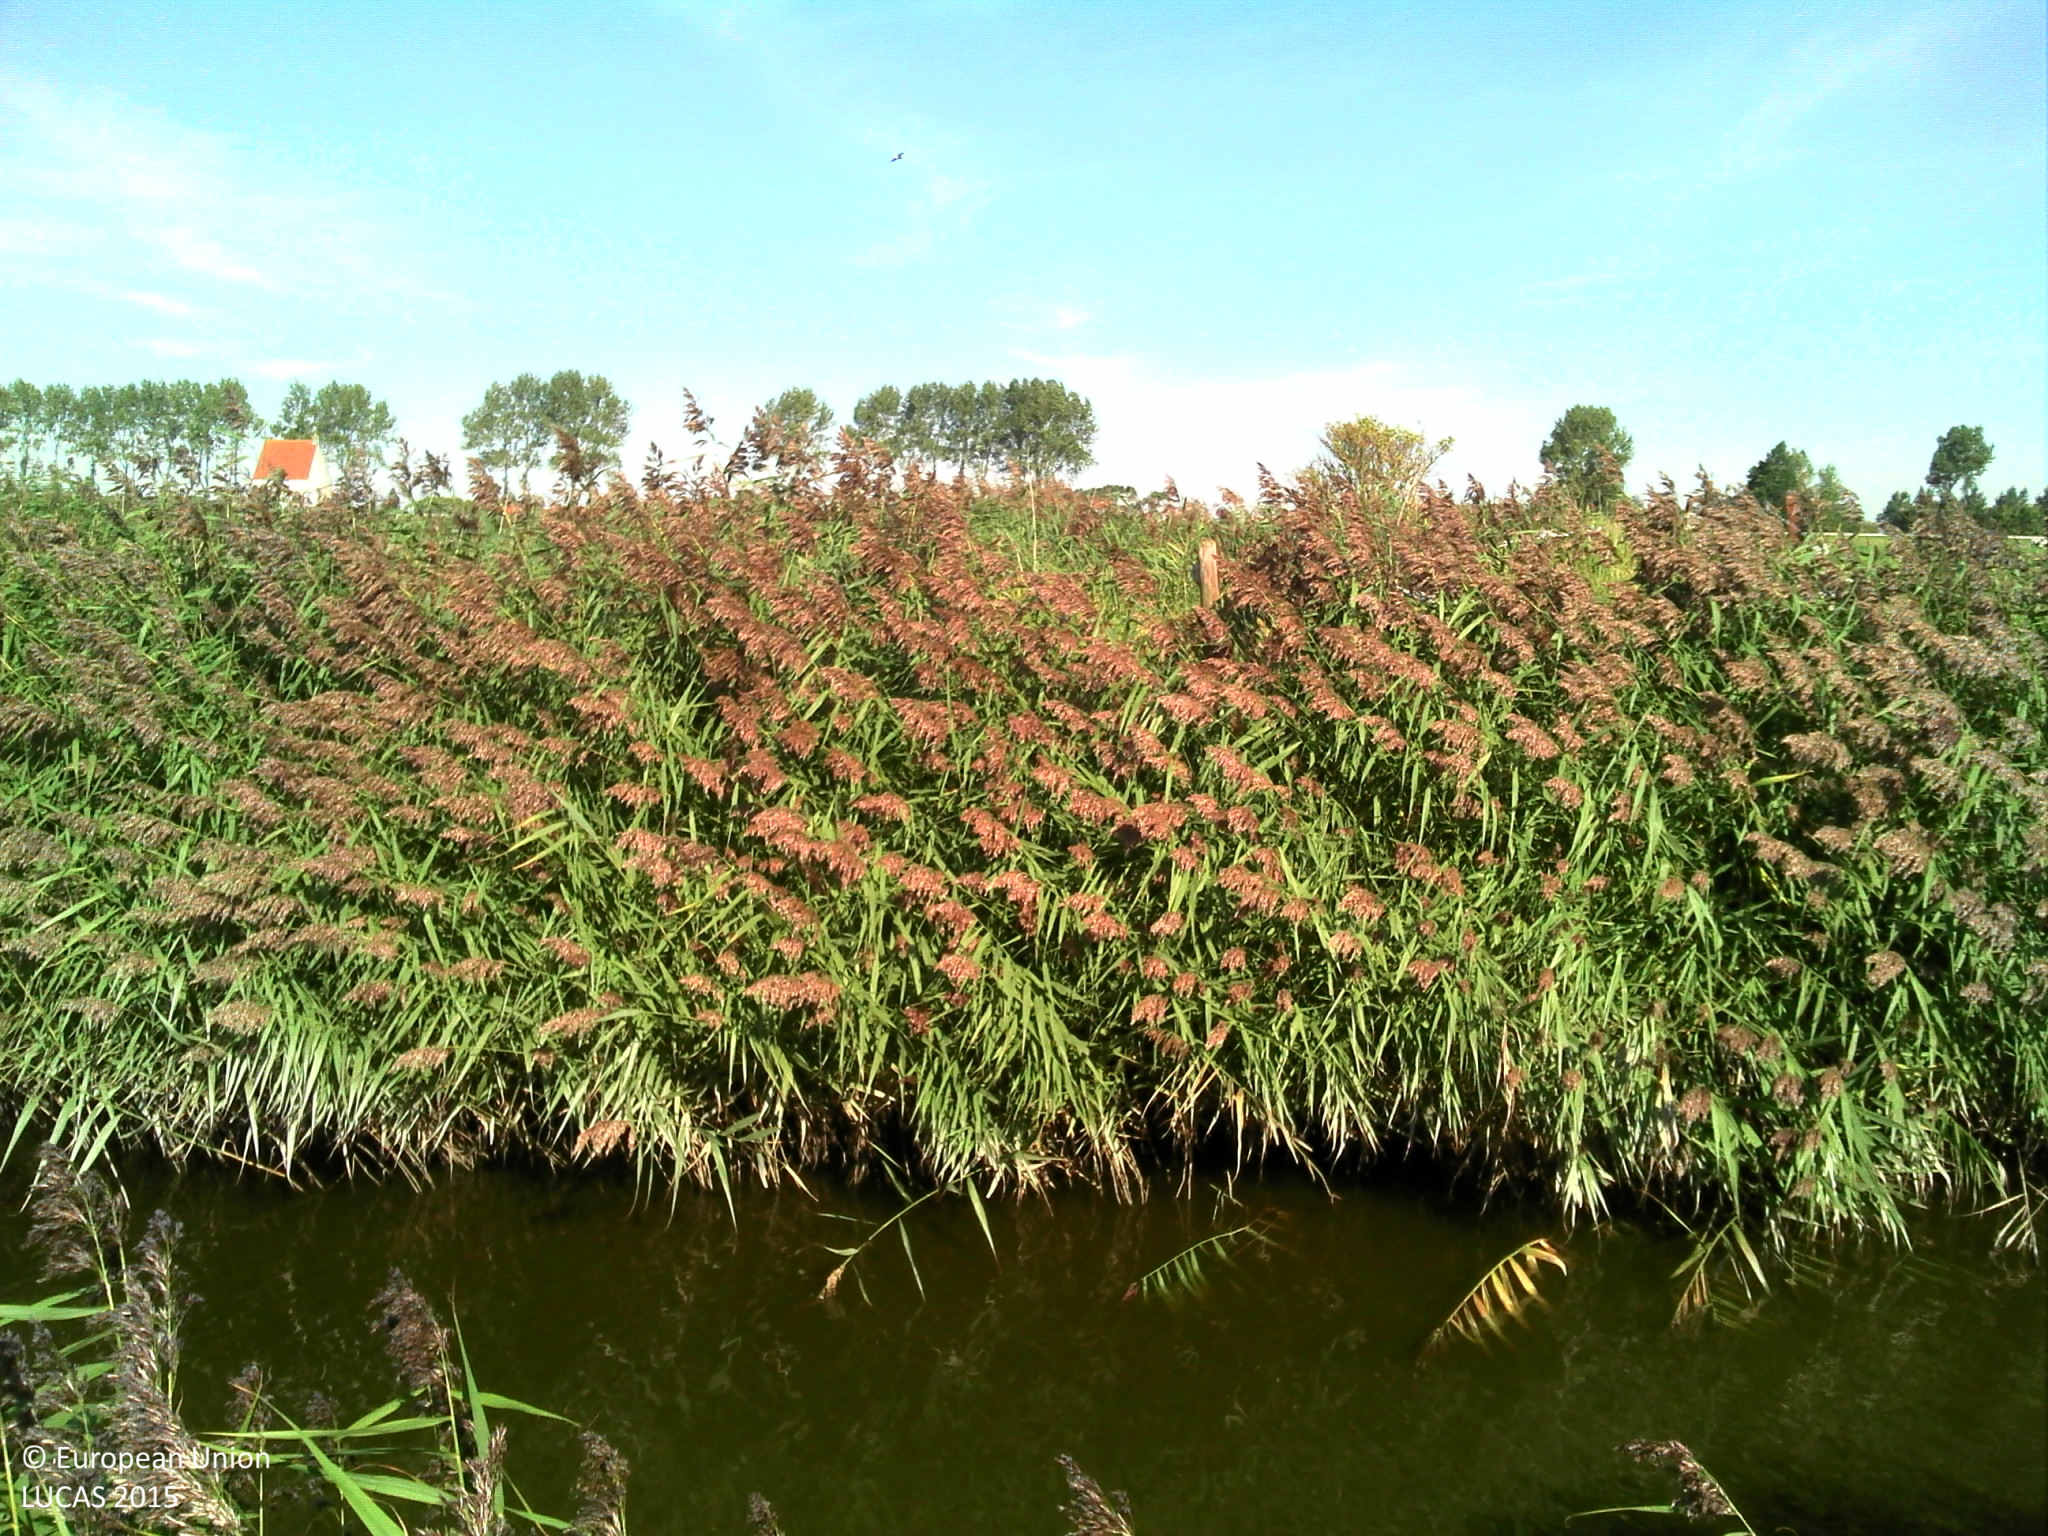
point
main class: Grassland
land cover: Grassland without tree/shrub cover
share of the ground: > 75 %
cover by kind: herbaceous plants 100 %
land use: Agriculture (excluding fallow land and kitchen gardens)
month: September
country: BE
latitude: 51.1479
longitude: 2.7983
